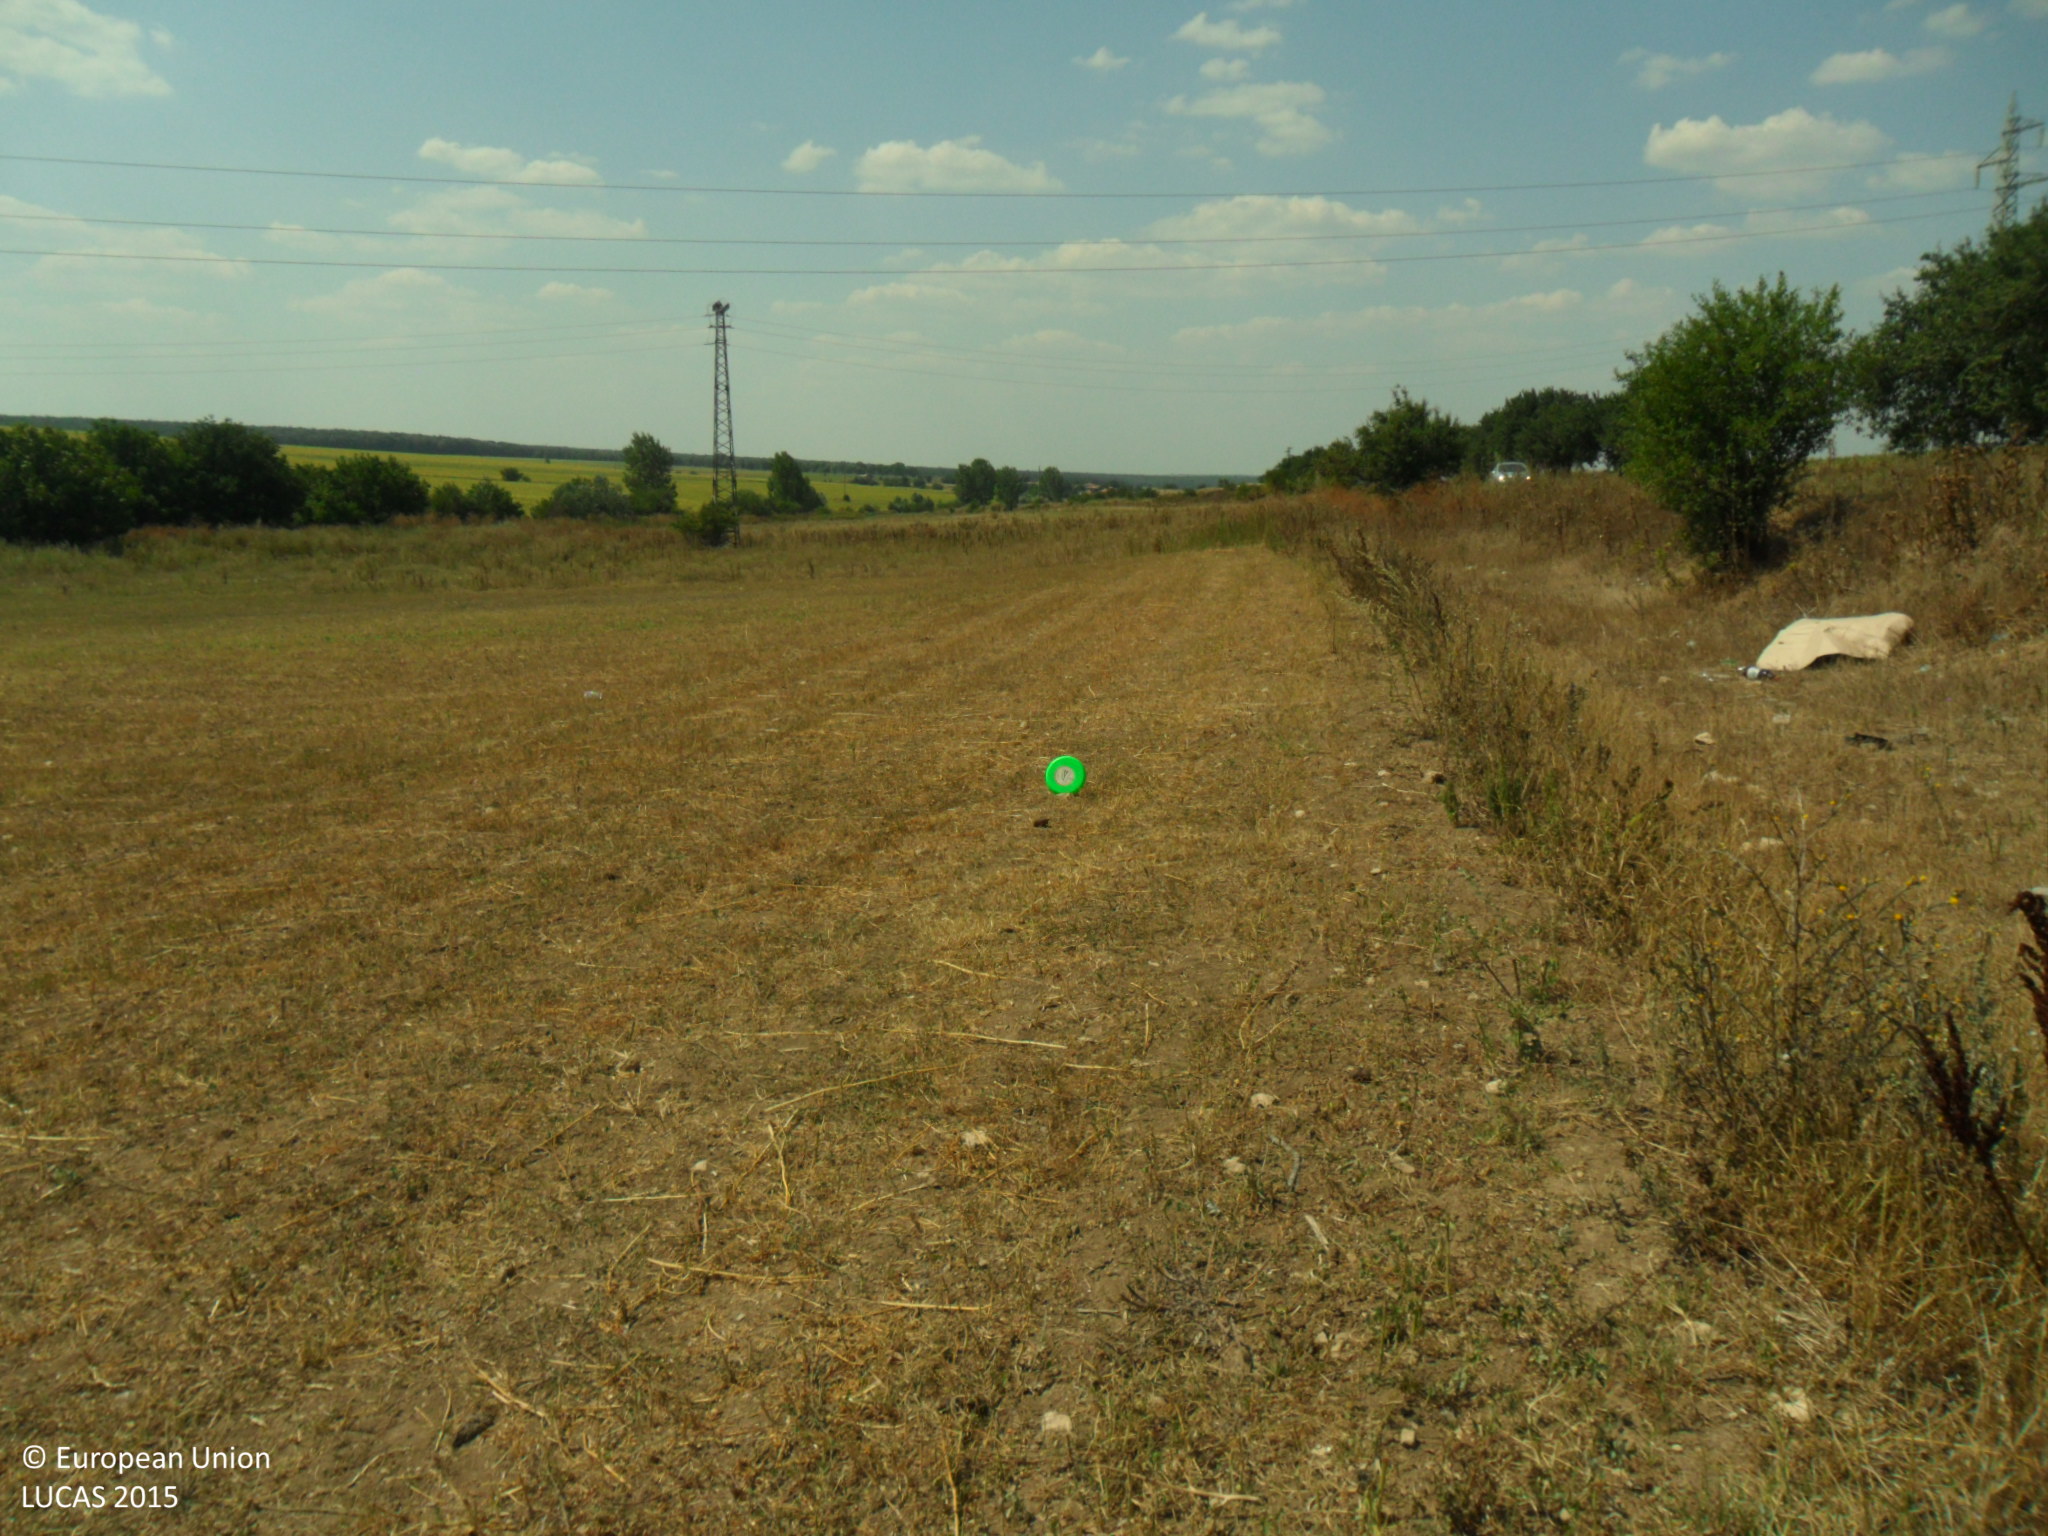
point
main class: Grassland
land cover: Grassland with sparse tree/shrub cover
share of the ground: > 75 %
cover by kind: herbaceous plants 90 %, broadleaved forest trees 5 %, shrubs 5 %
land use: Agriculture (excluding fallow land and kitchen gardens)
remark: Harvested field
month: August
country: BG
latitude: 43.5418
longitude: 27.1132
